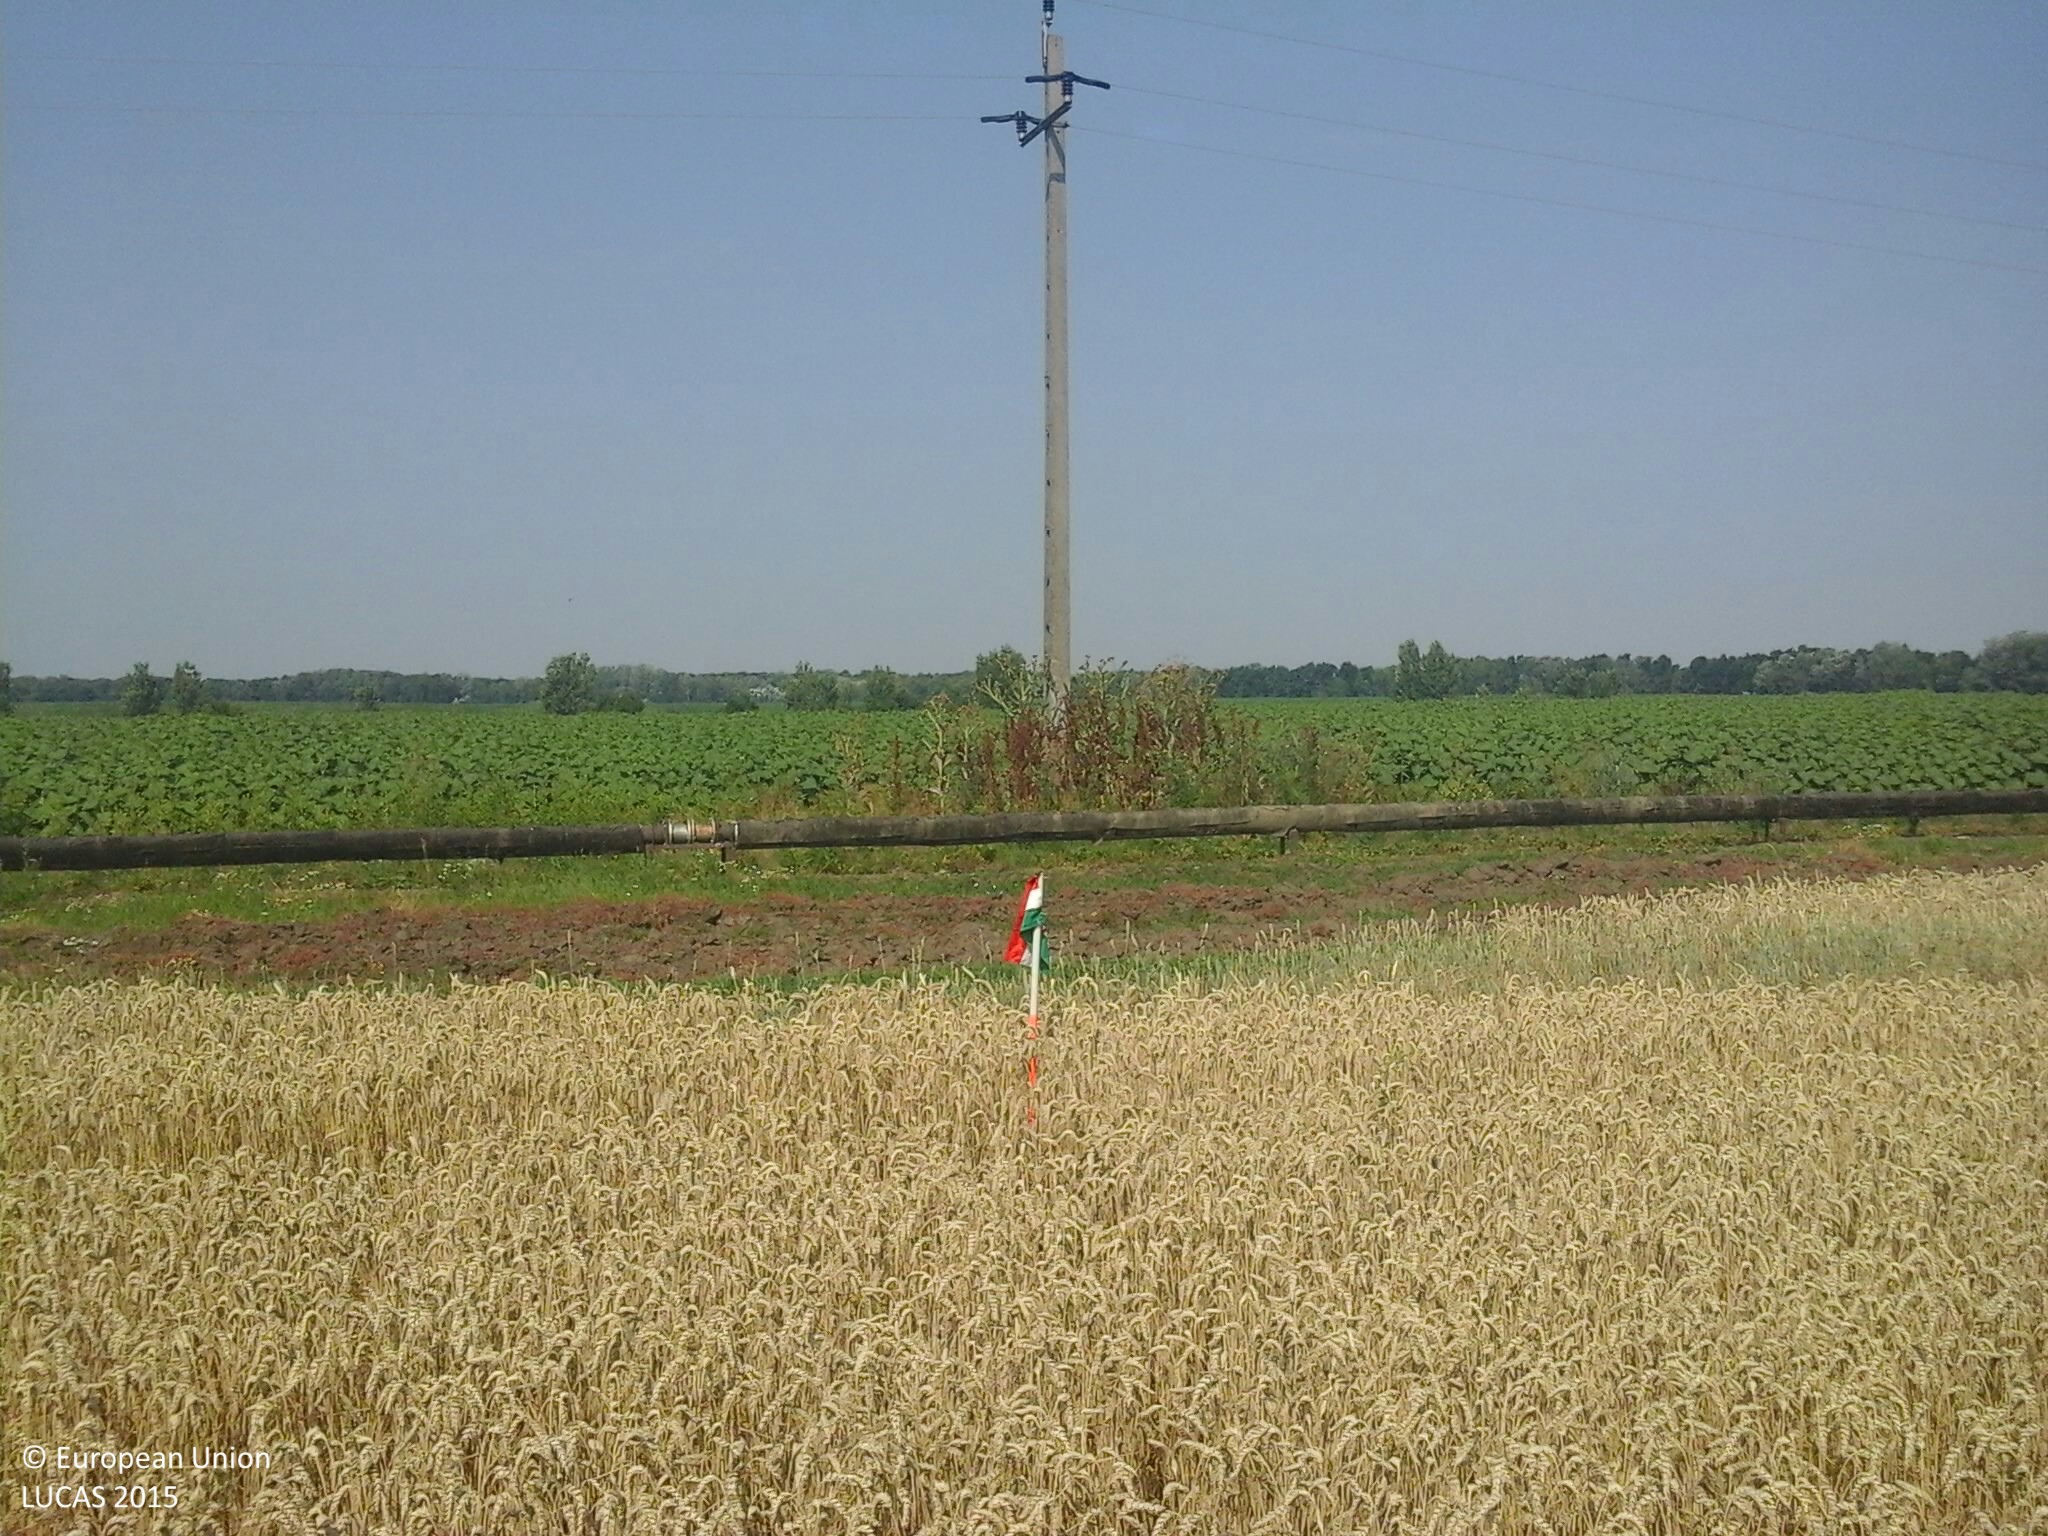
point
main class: Cropland
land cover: Common wheat
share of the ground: > 75 %
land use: Agriculture (excluding fallow land and kitchen gardens)
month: July
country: HU
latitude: 46.7013
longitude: 20.3449
